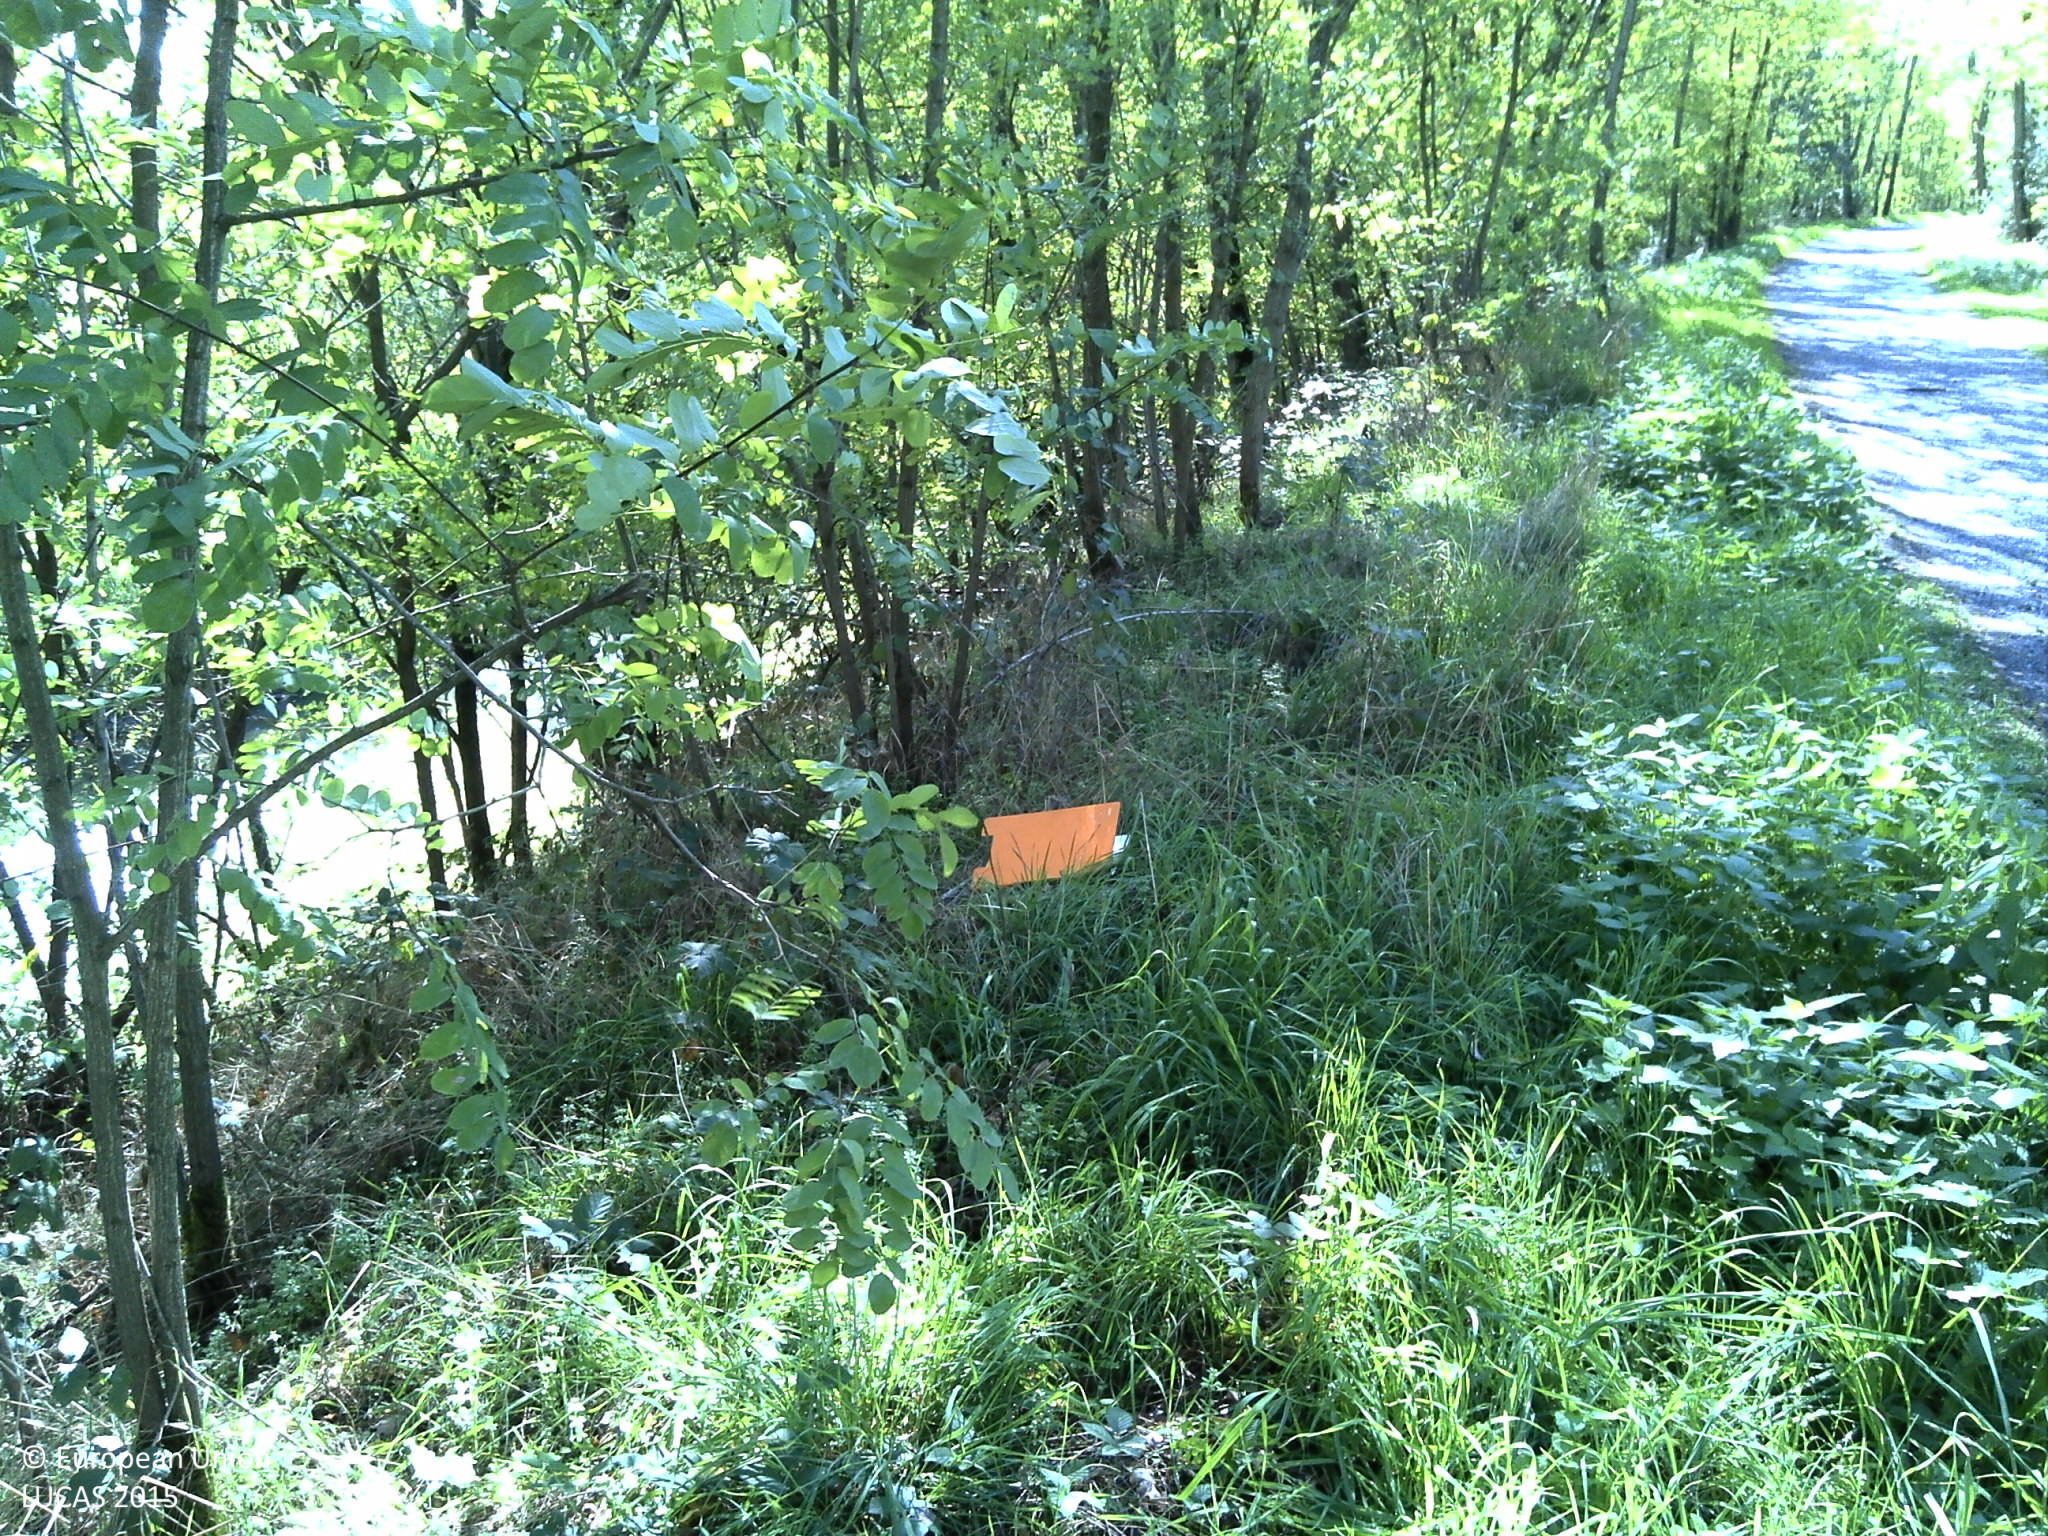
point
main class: Woodland
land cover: Broadleaved woodland
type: mesophytic deciduous forest
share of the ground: > 75 %
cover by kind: broadleaved forest trees 80 %, herbaceous plants 20 %
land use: Semi-natural and natural areas not in use
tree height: > 5 m
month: October
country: FR
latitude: 46.5835
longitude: 4.0623
